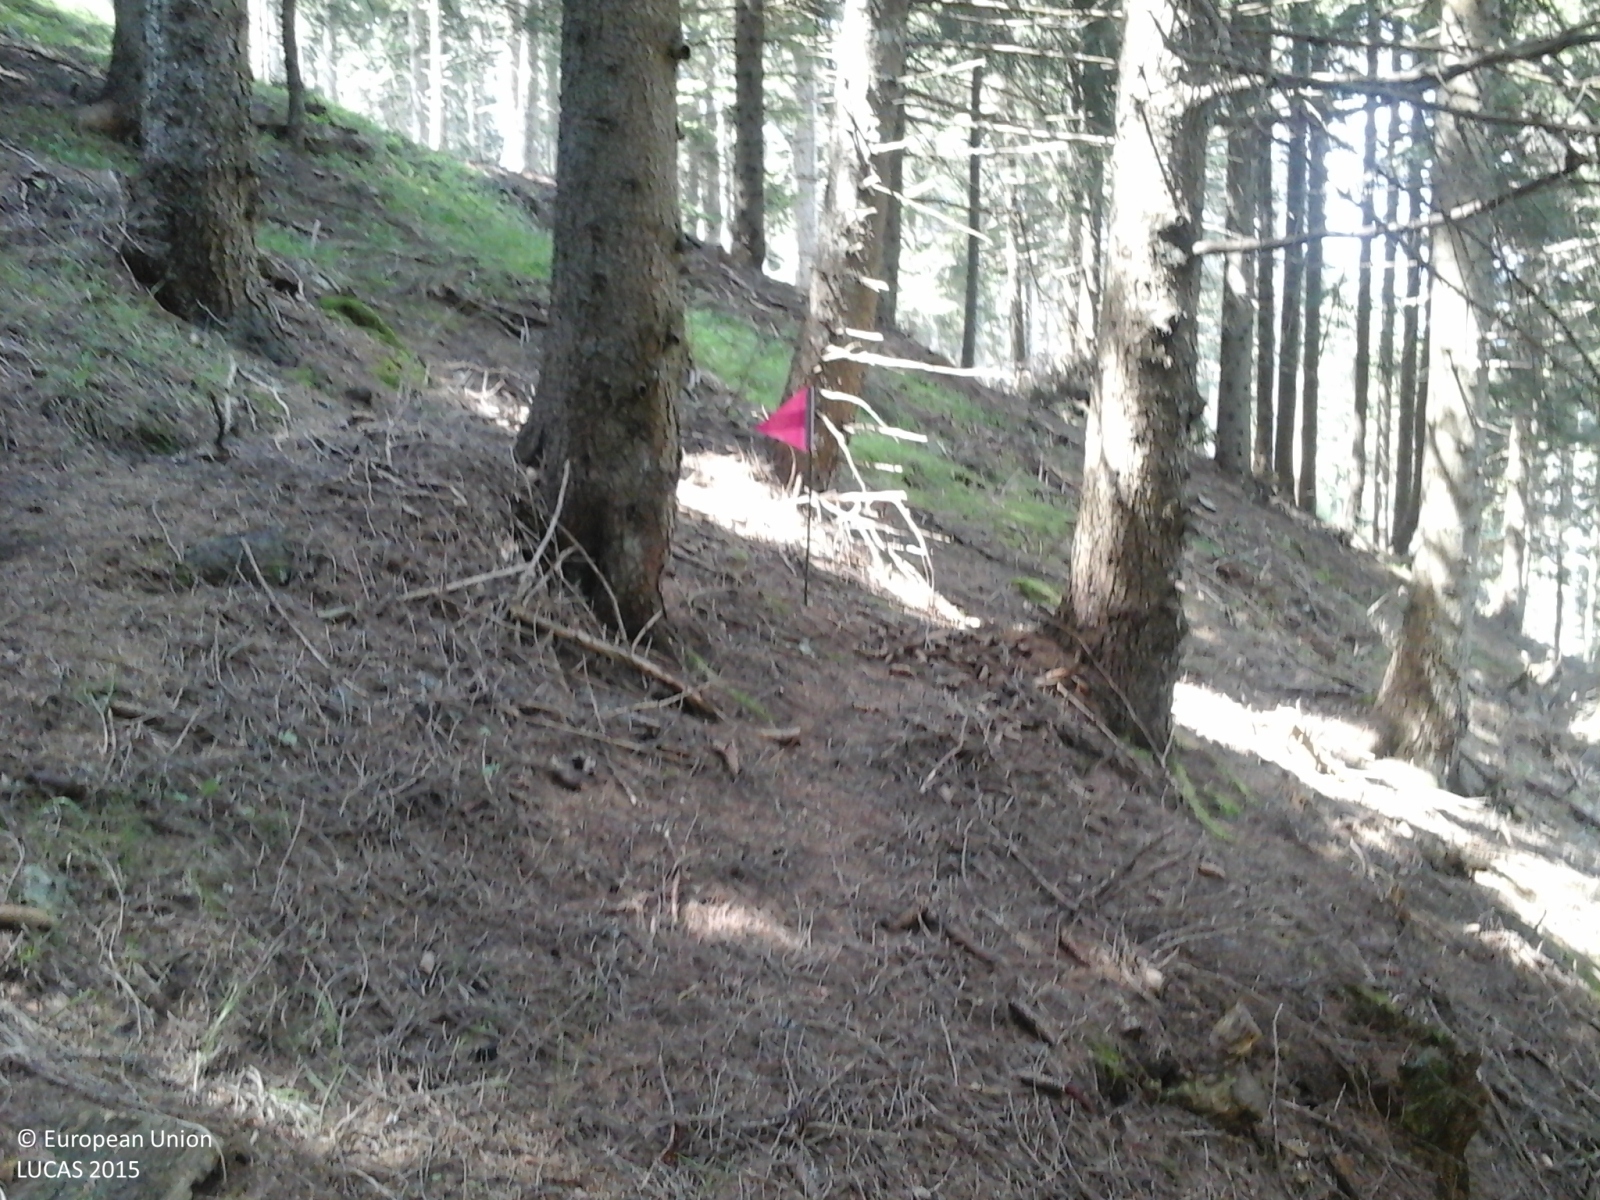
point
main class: Woodland
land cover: Spruce dominated coniferous woodland
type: alpine coniferous forest
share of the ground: > 75 %
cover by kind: coniferous forest trees 100 %
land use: Forestry
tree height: > 5 m
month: June
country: IT
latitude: 46.6517
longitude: 11.1093
